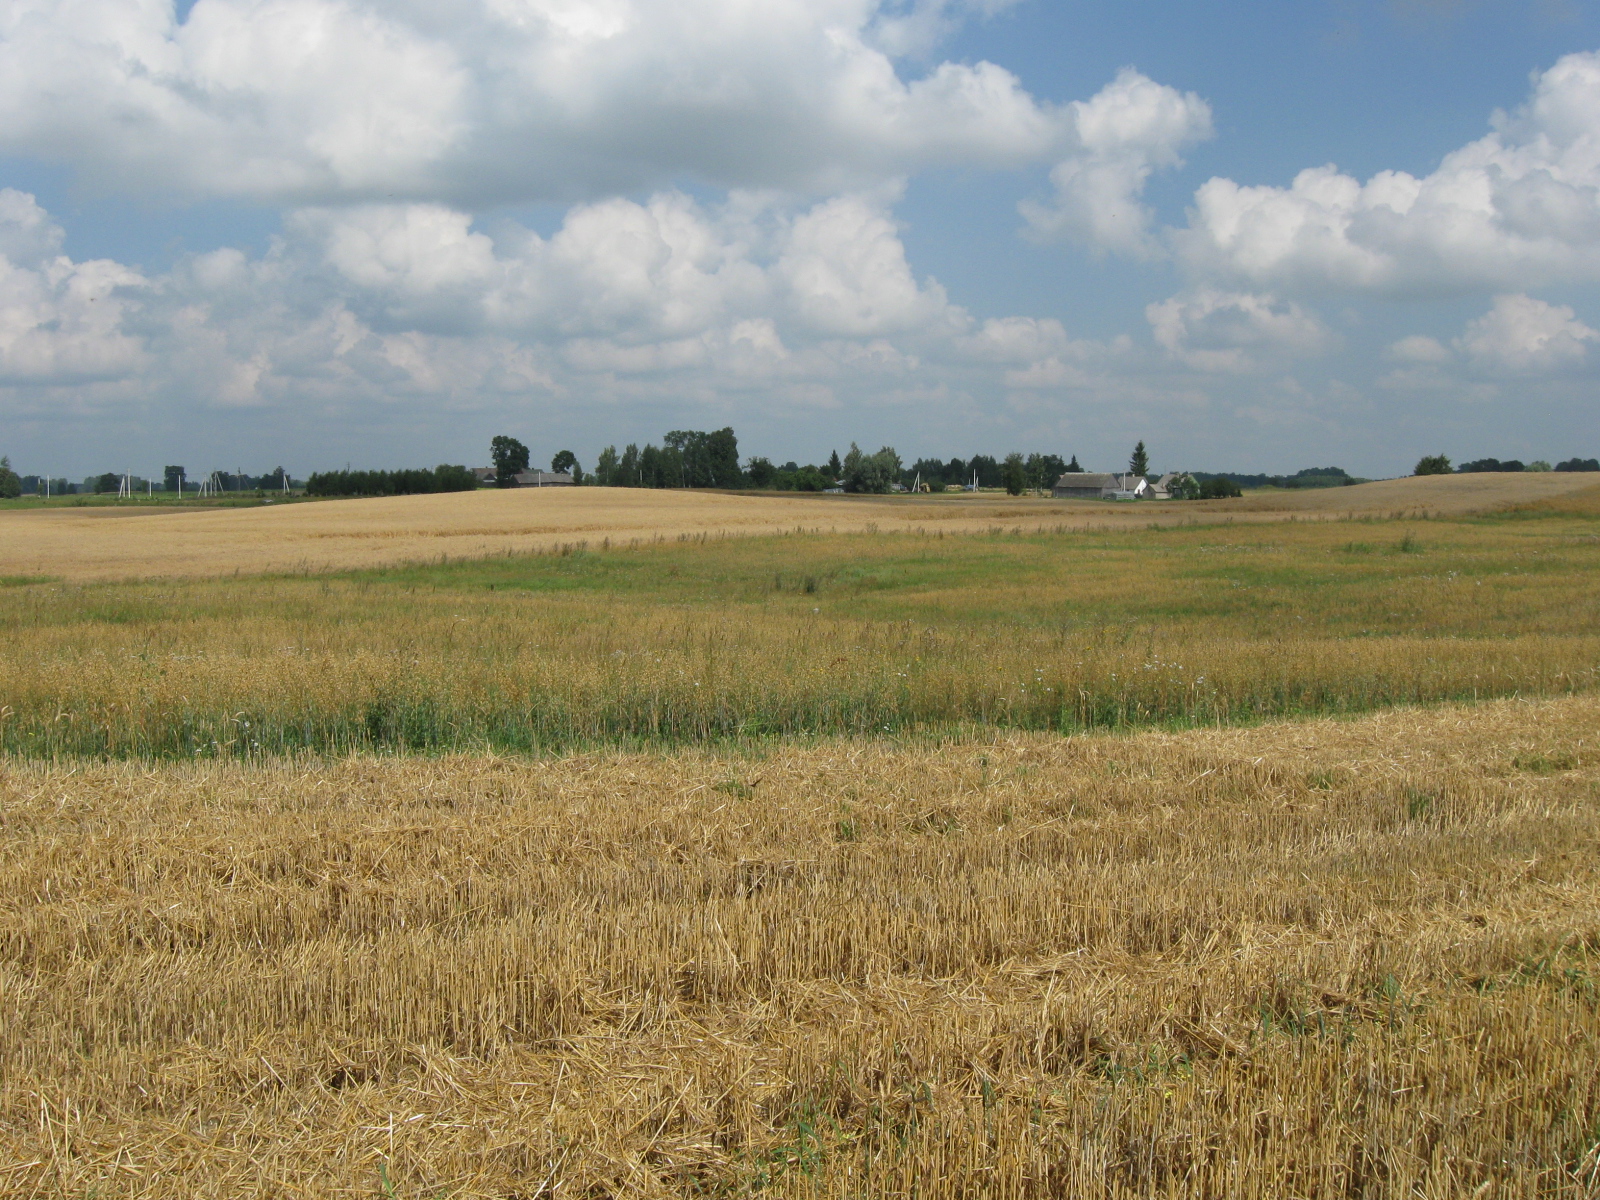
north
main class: Cropland
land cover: Common wheat
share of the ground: > 75 %
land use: Agriculture (excluding fallow land and kitchen gardens)
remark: Harvested field
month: August
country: LT
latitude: 54.7034
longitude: 23.6635
